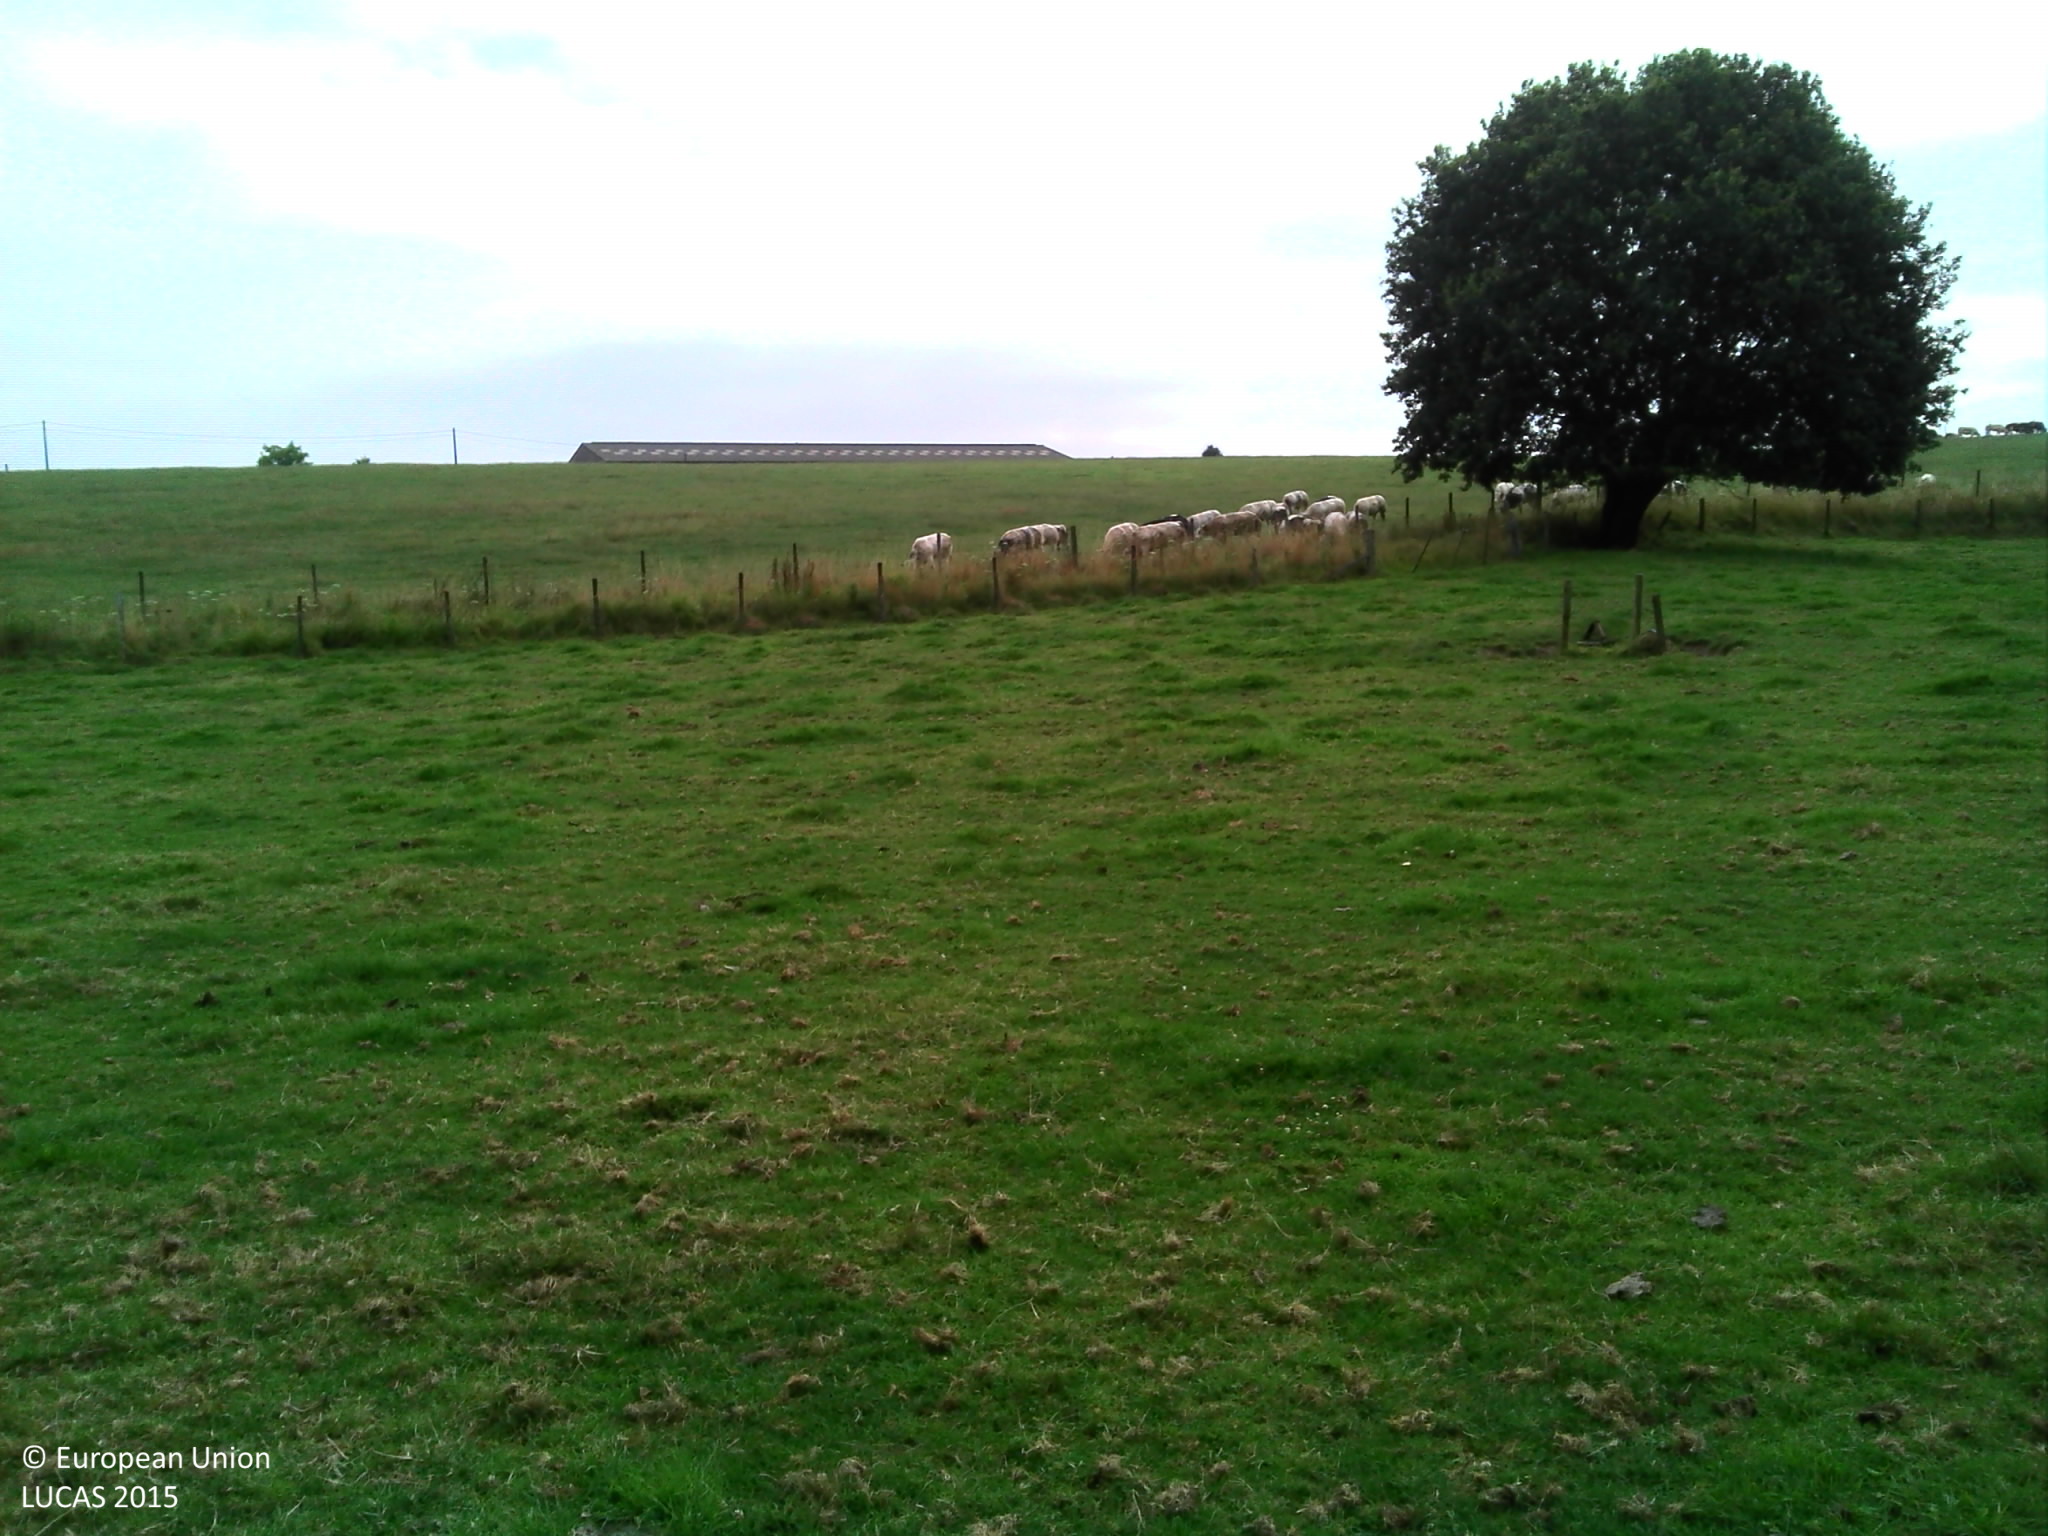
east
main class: Grassland
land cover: Grassland without tree/shrub cover
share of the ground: > 75 %
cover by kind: herbaceous plants 100 %
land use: Agriculture (excluding fallow land and kitchen gardens)
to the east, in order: Grassland without tree/shrub cover; Fences; Tracks; Fences; Grassland without tree/shrub cover; Other bare soil; Artificial constructions in urban areas
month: August
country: BE
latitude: 50.6817
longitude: 3.7803
